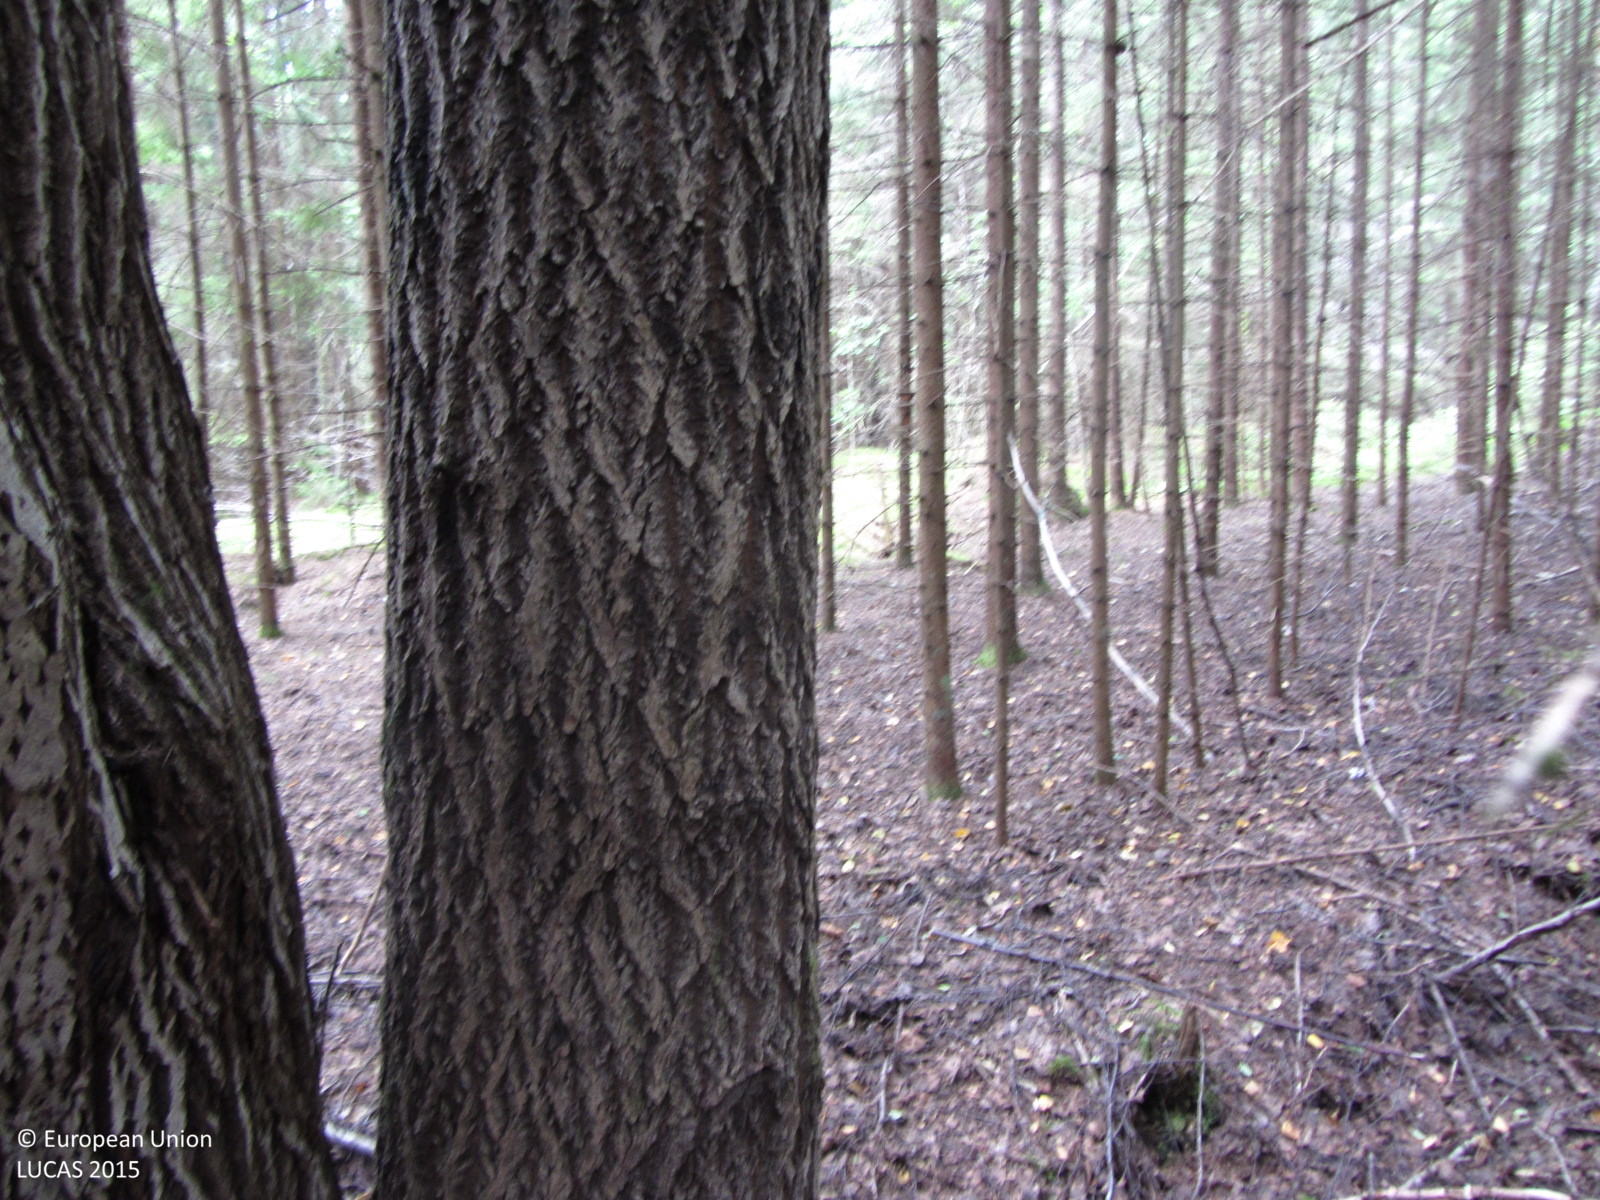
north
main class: Woodland
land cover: Spruce dominated mixed woodland
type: boreal forest
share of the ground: > 75 %
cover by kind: coniferous forest trees 70 %, broadleaved forest trees 30 %
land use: Forestry
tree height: > 5 m
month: August
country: FI
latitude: 60.2835
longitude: 23.8207
